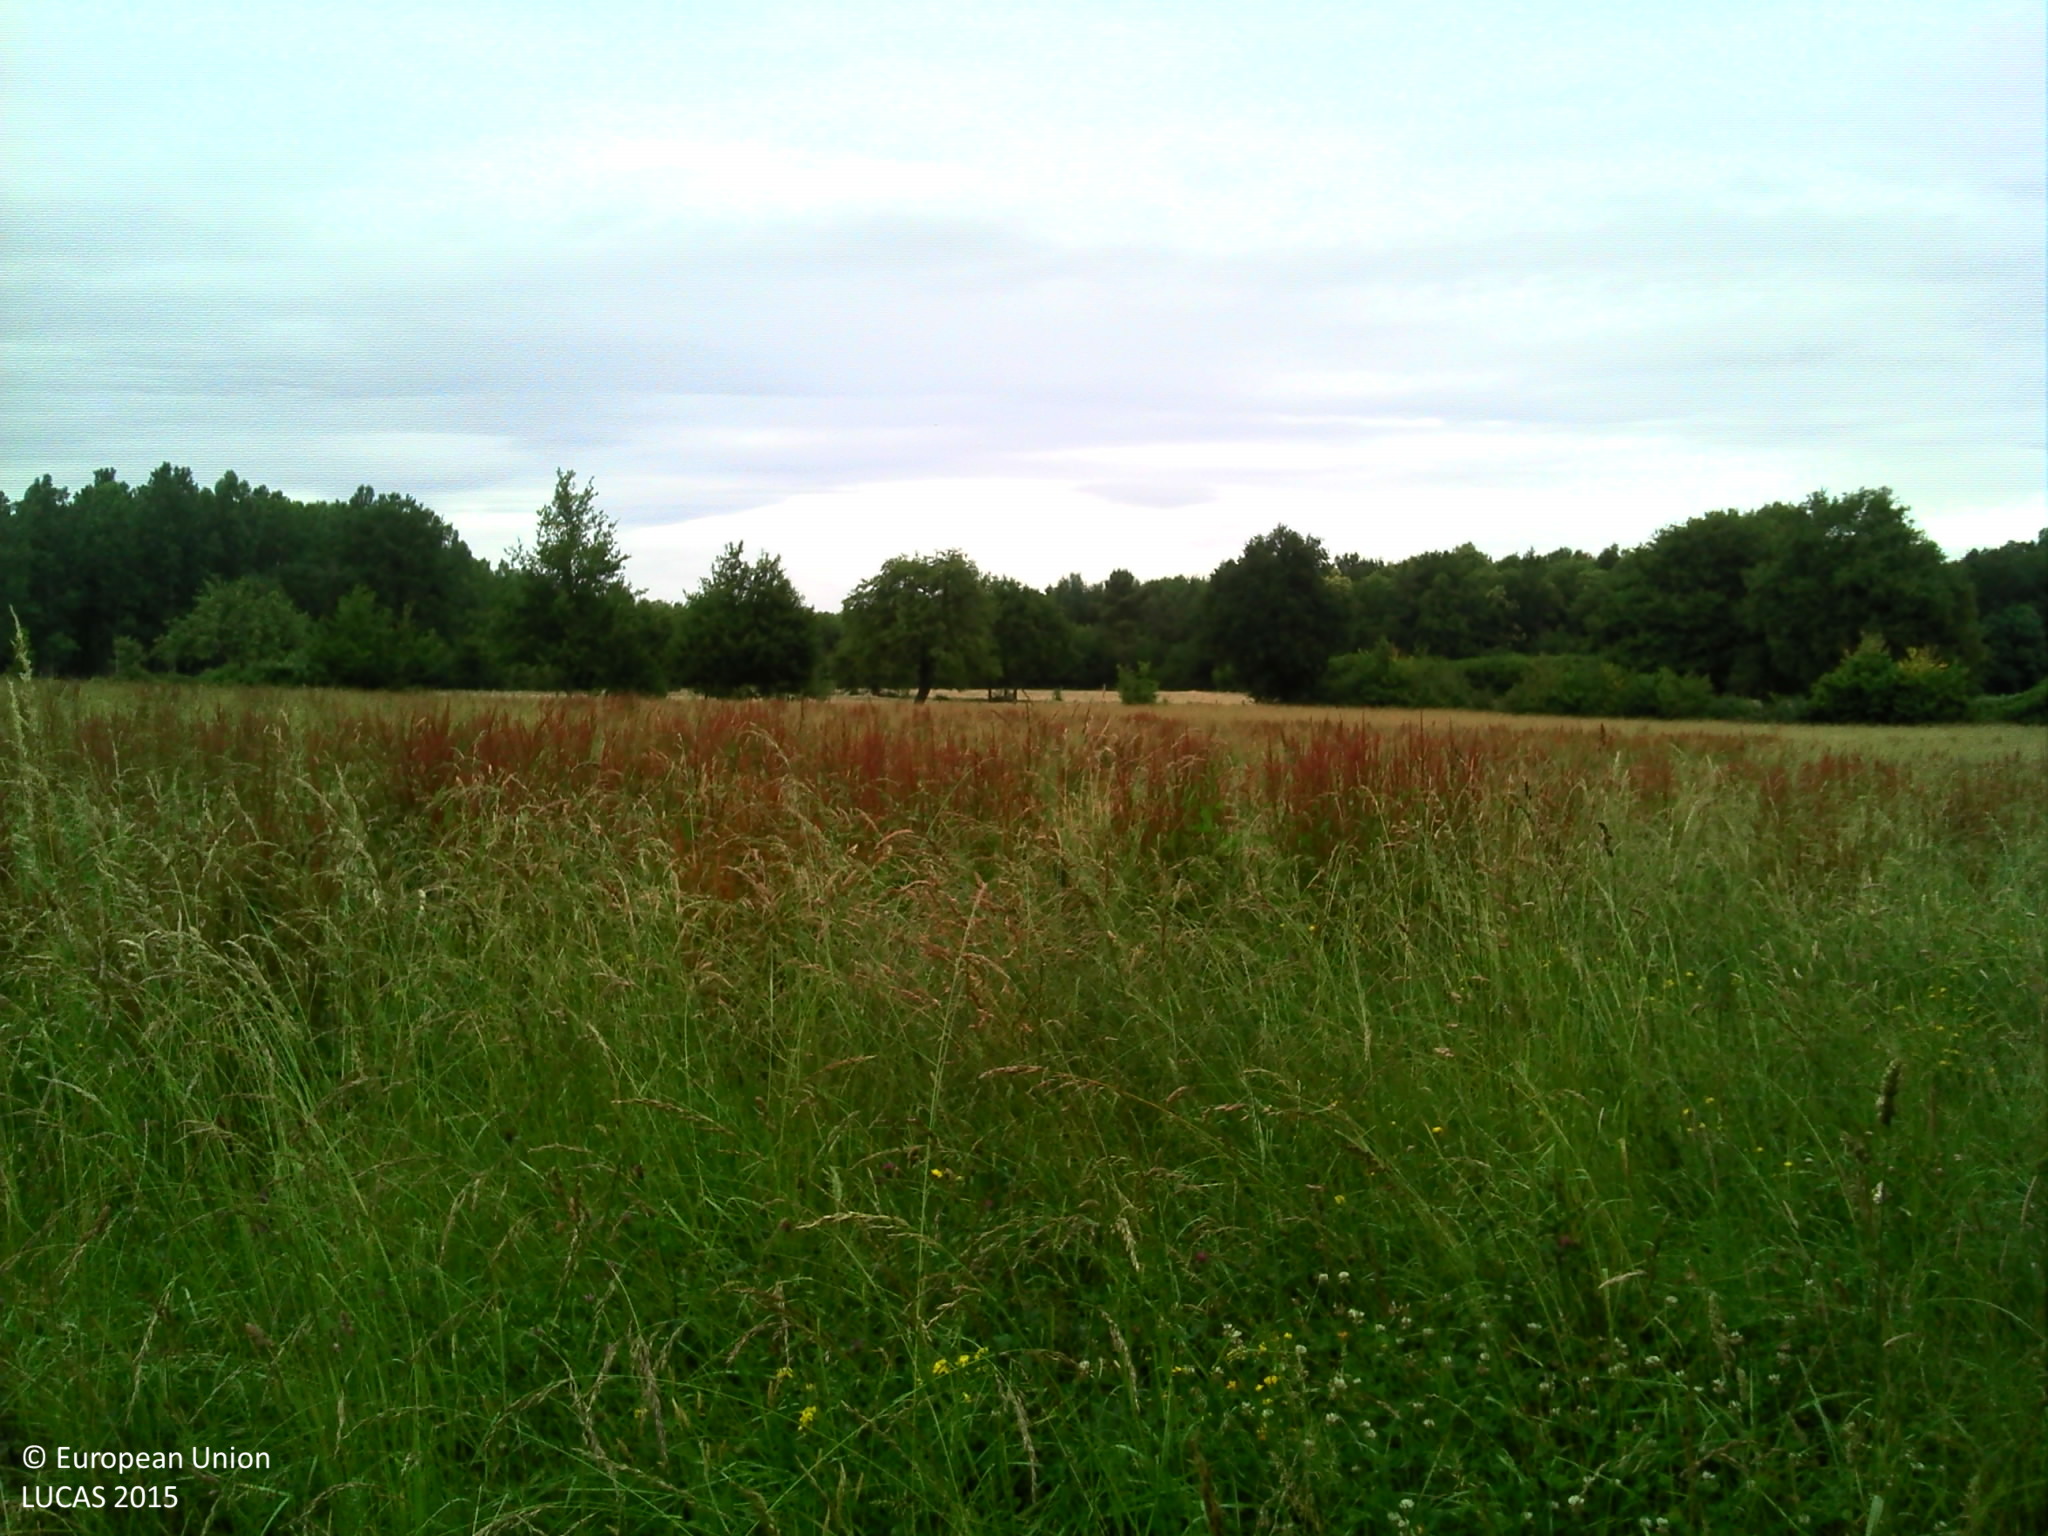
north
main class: Grassland
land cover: Grassland without tree/shrub cover
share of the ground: > 75 %
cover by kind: herbaceous plants 100 %
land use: Agriculture (excluding fallow land and kitchen gardens)
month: June
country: FR
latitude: 47.6306
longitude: 0.0864
